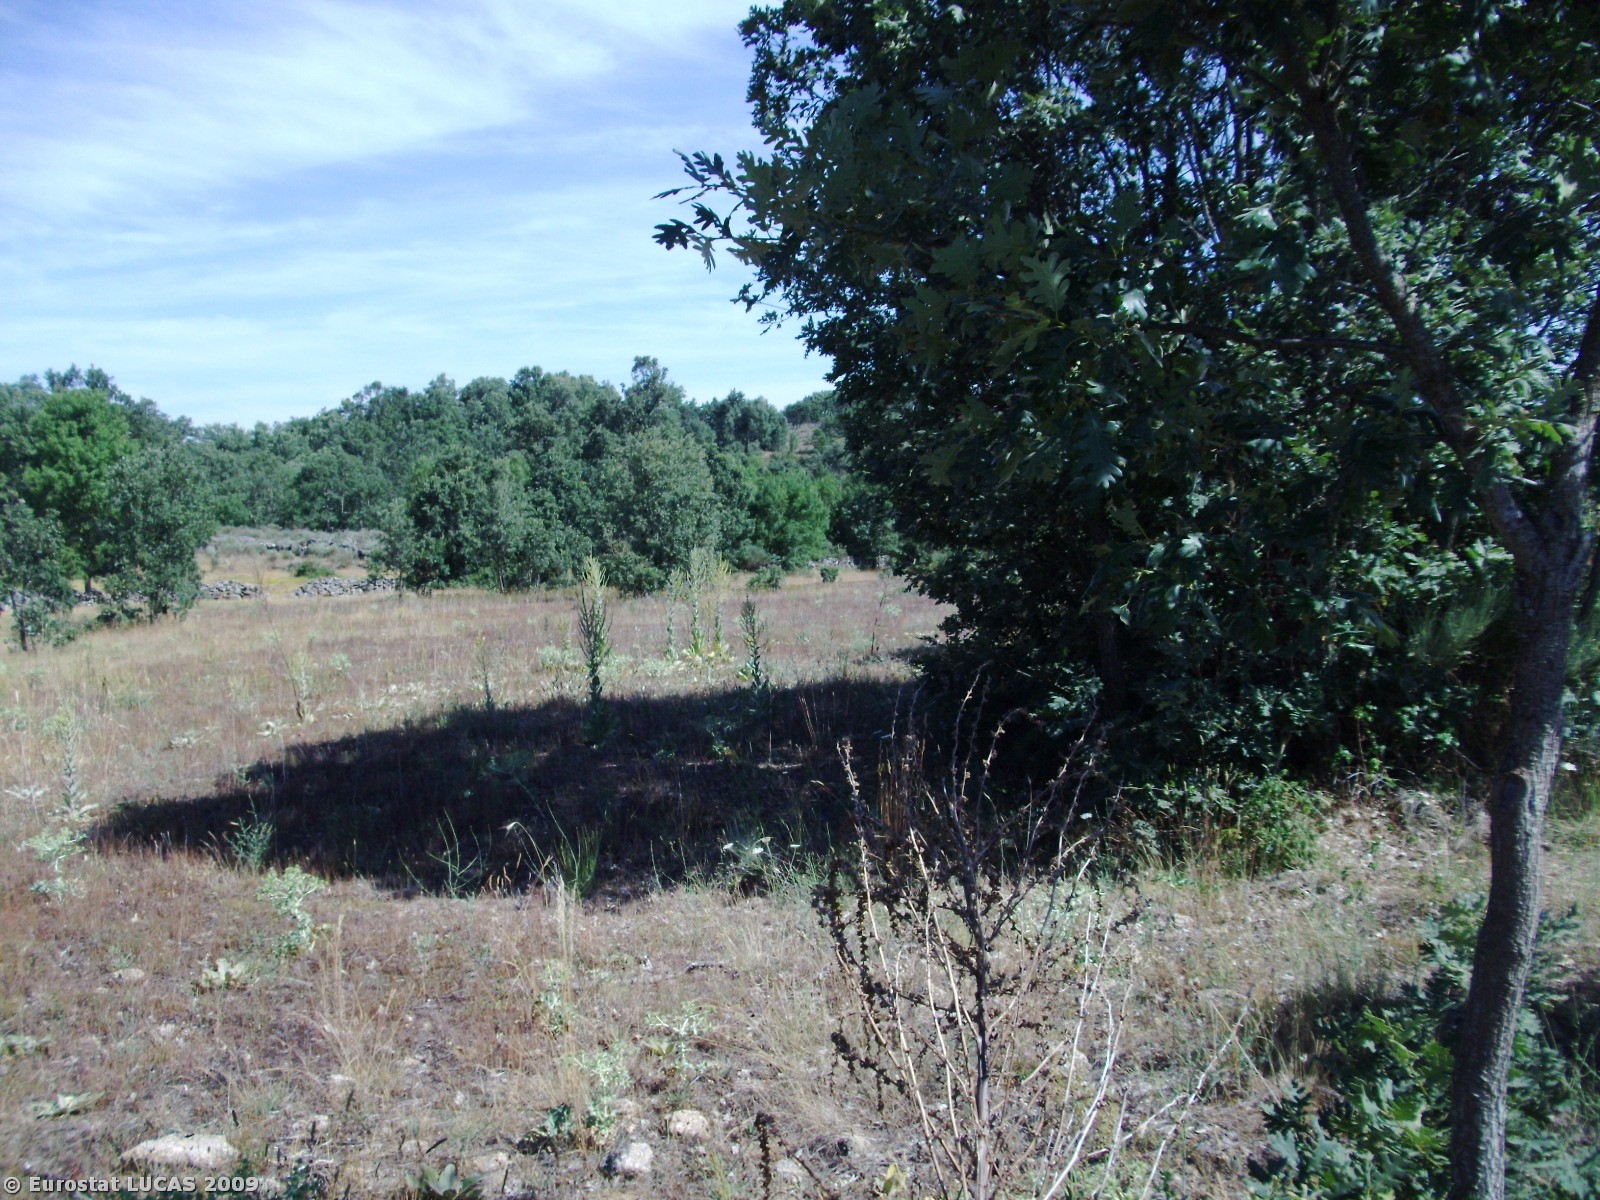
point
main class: Grassland
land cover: Spontaneously vegetated surfaces
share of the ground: > 75 %
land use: Fallow land
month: July
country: PT
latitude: 40.3726
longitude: -6.8046
